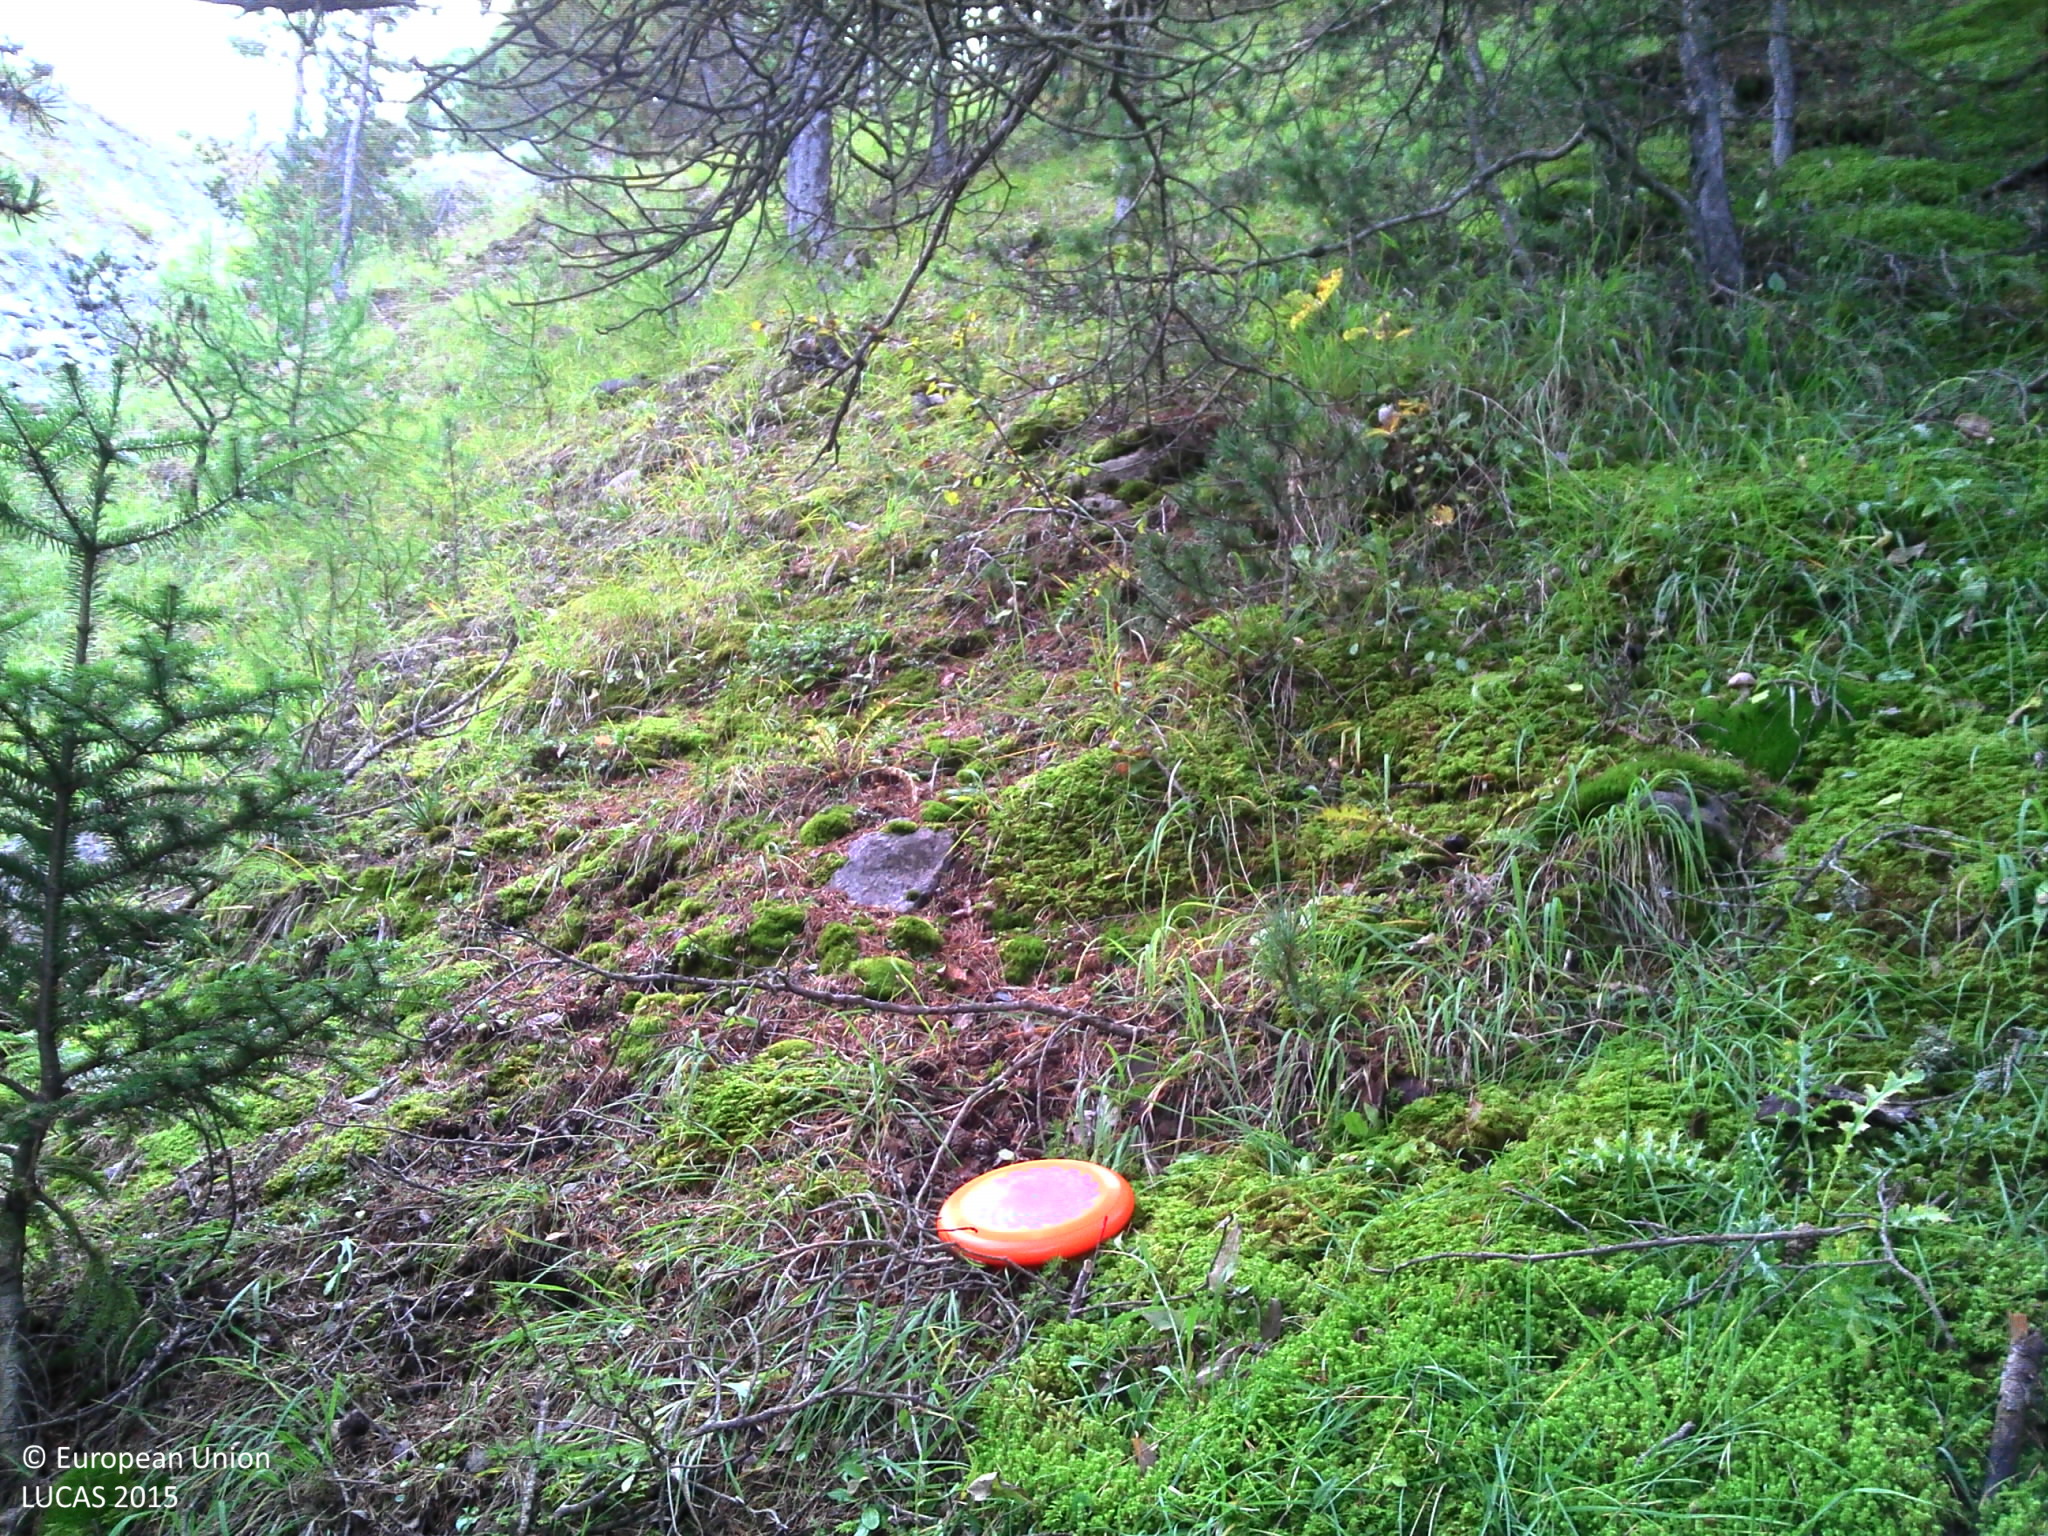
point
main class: Woodland
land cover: Other coniferous woodland
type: alpine coniferous forest
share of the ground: > 75 %
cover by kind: coniferous forest trees 80 %, herbaceous plants 15 %, consolidated bare surface 5 %
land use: Forestry
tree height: > 5 m
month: September
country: FR
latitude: 44.4917
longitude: 6.5482
